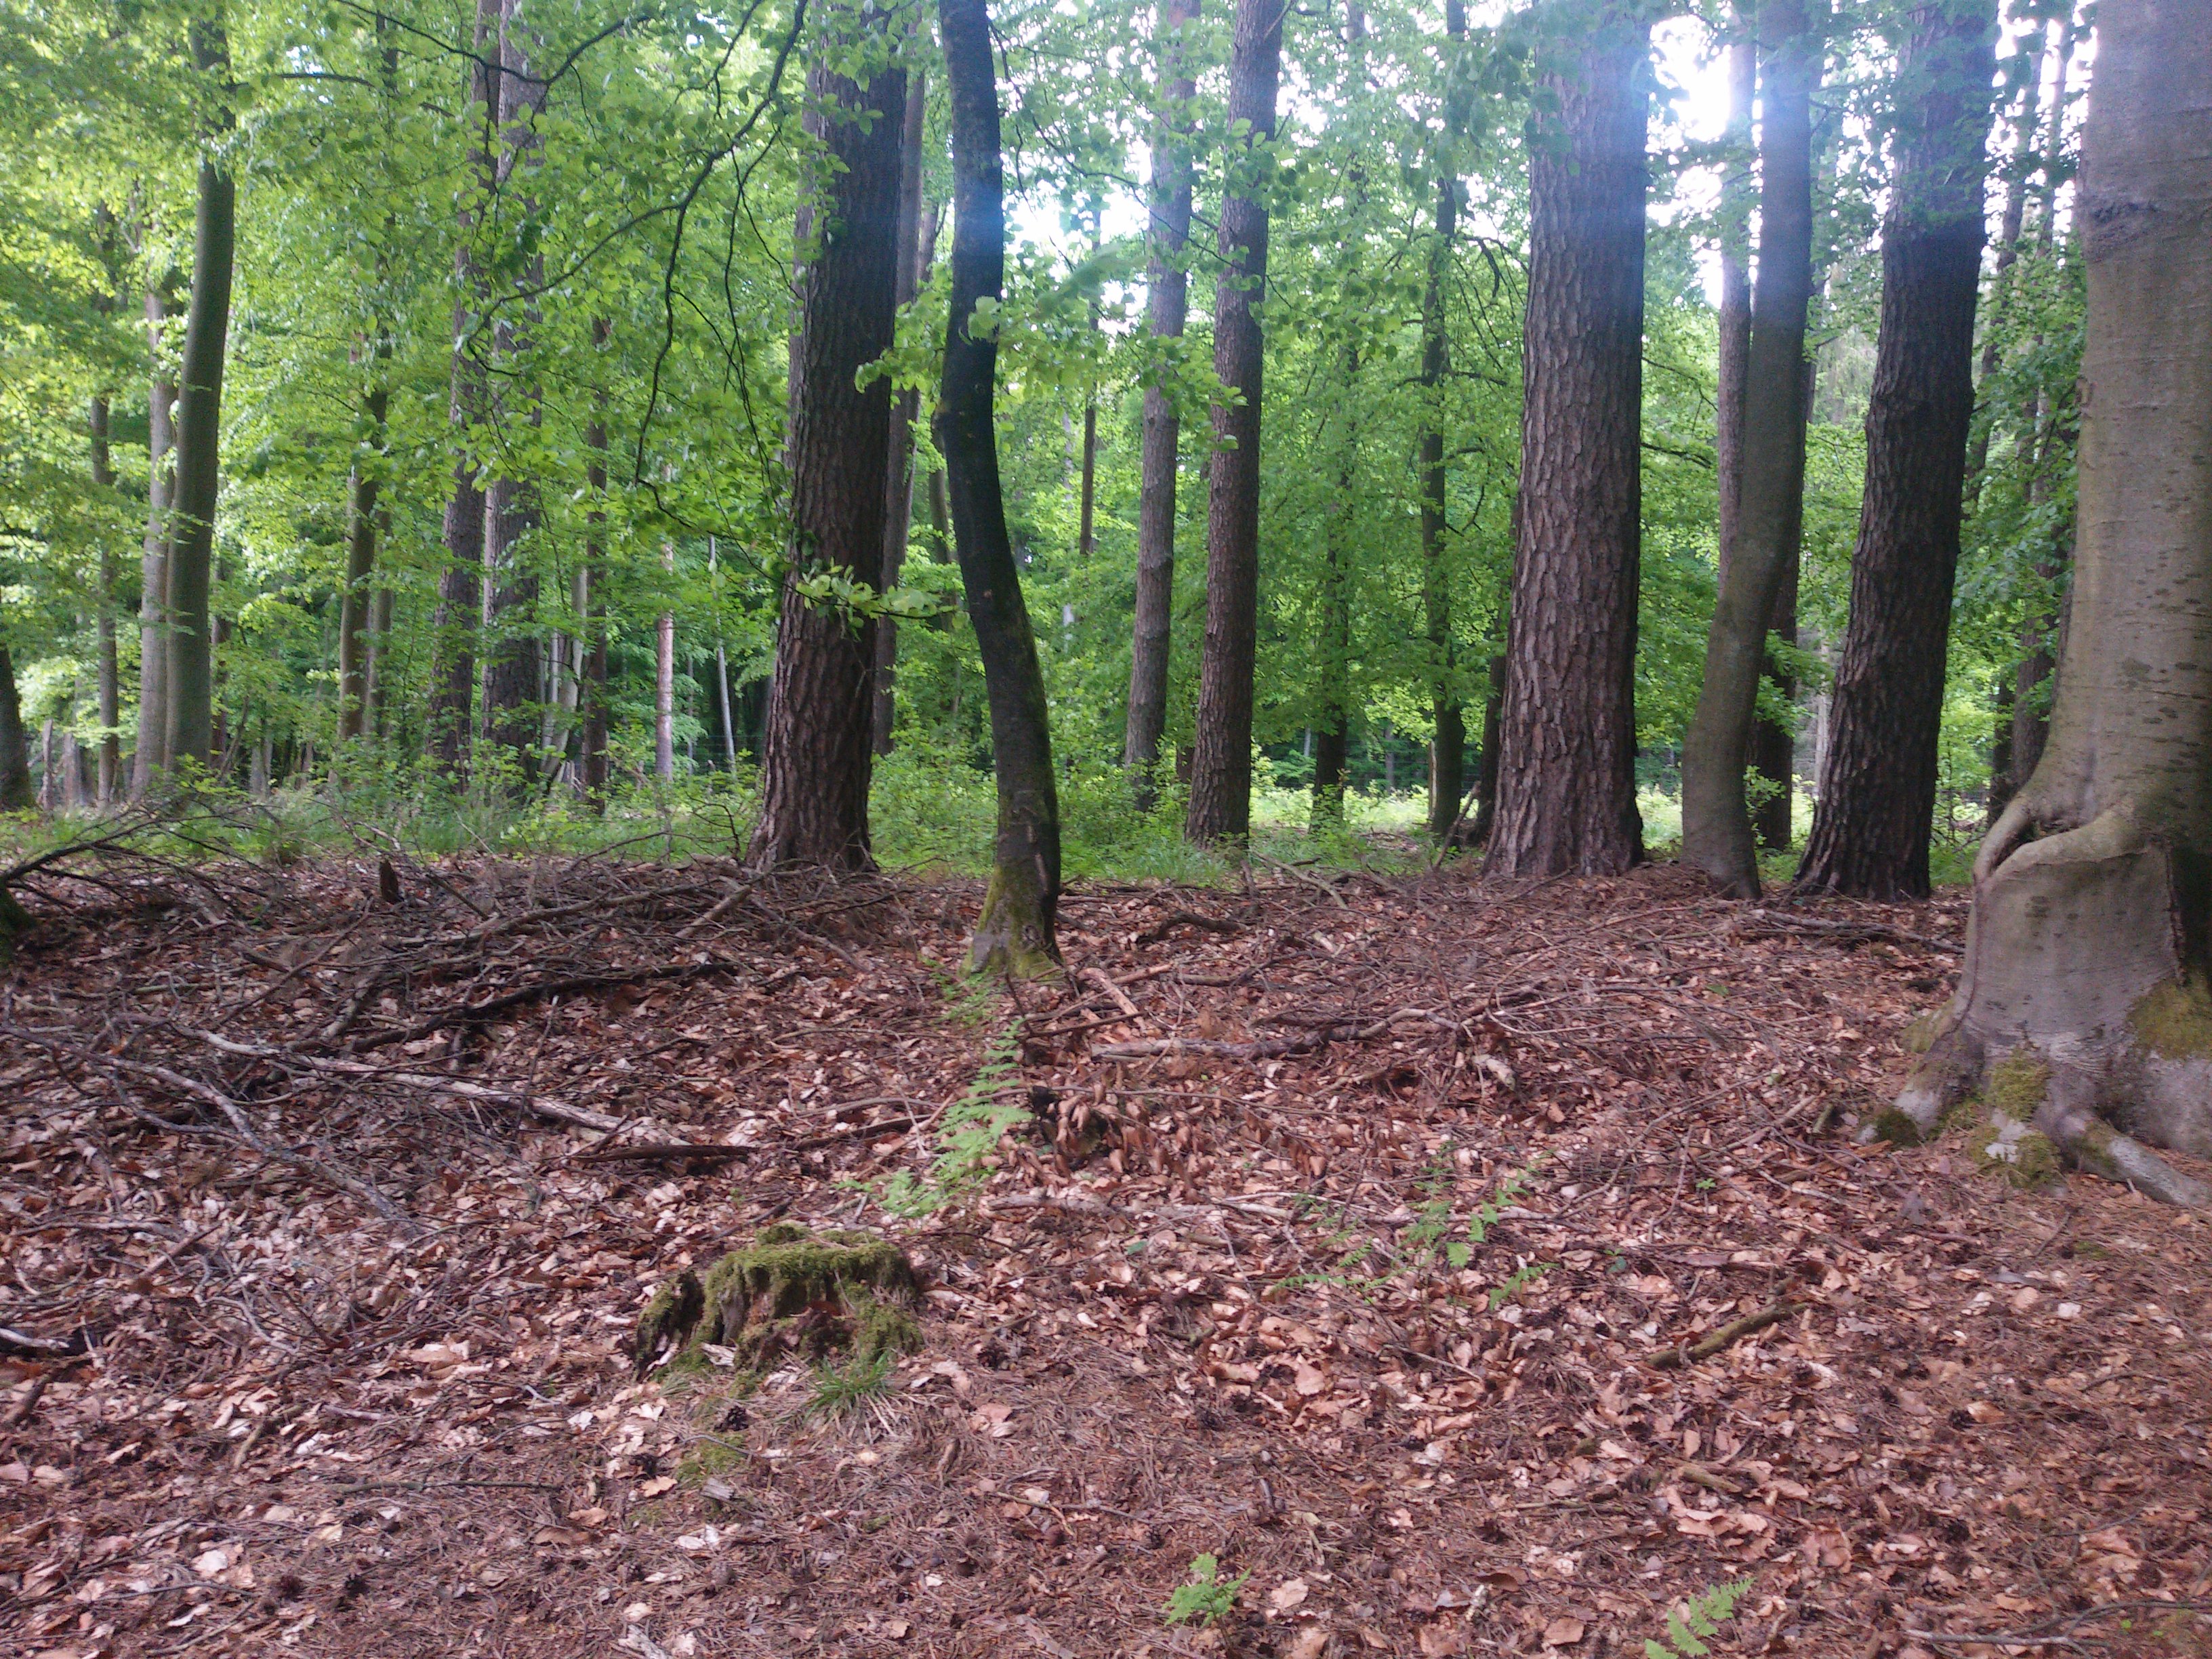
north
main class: Woodland
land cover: Pine dominated mixed woodland
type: hemiboreal forest and nemoral coniferous forest and mixed broadleaved-coniferous forest
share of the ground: > 75 %
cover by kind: coniferous forest trees 60 %, broadleaved forest trees 40 %
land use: Forestry
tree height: > 5 m
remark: Nursery
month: May
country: PL
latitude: 53.6492
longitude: 14.3123
